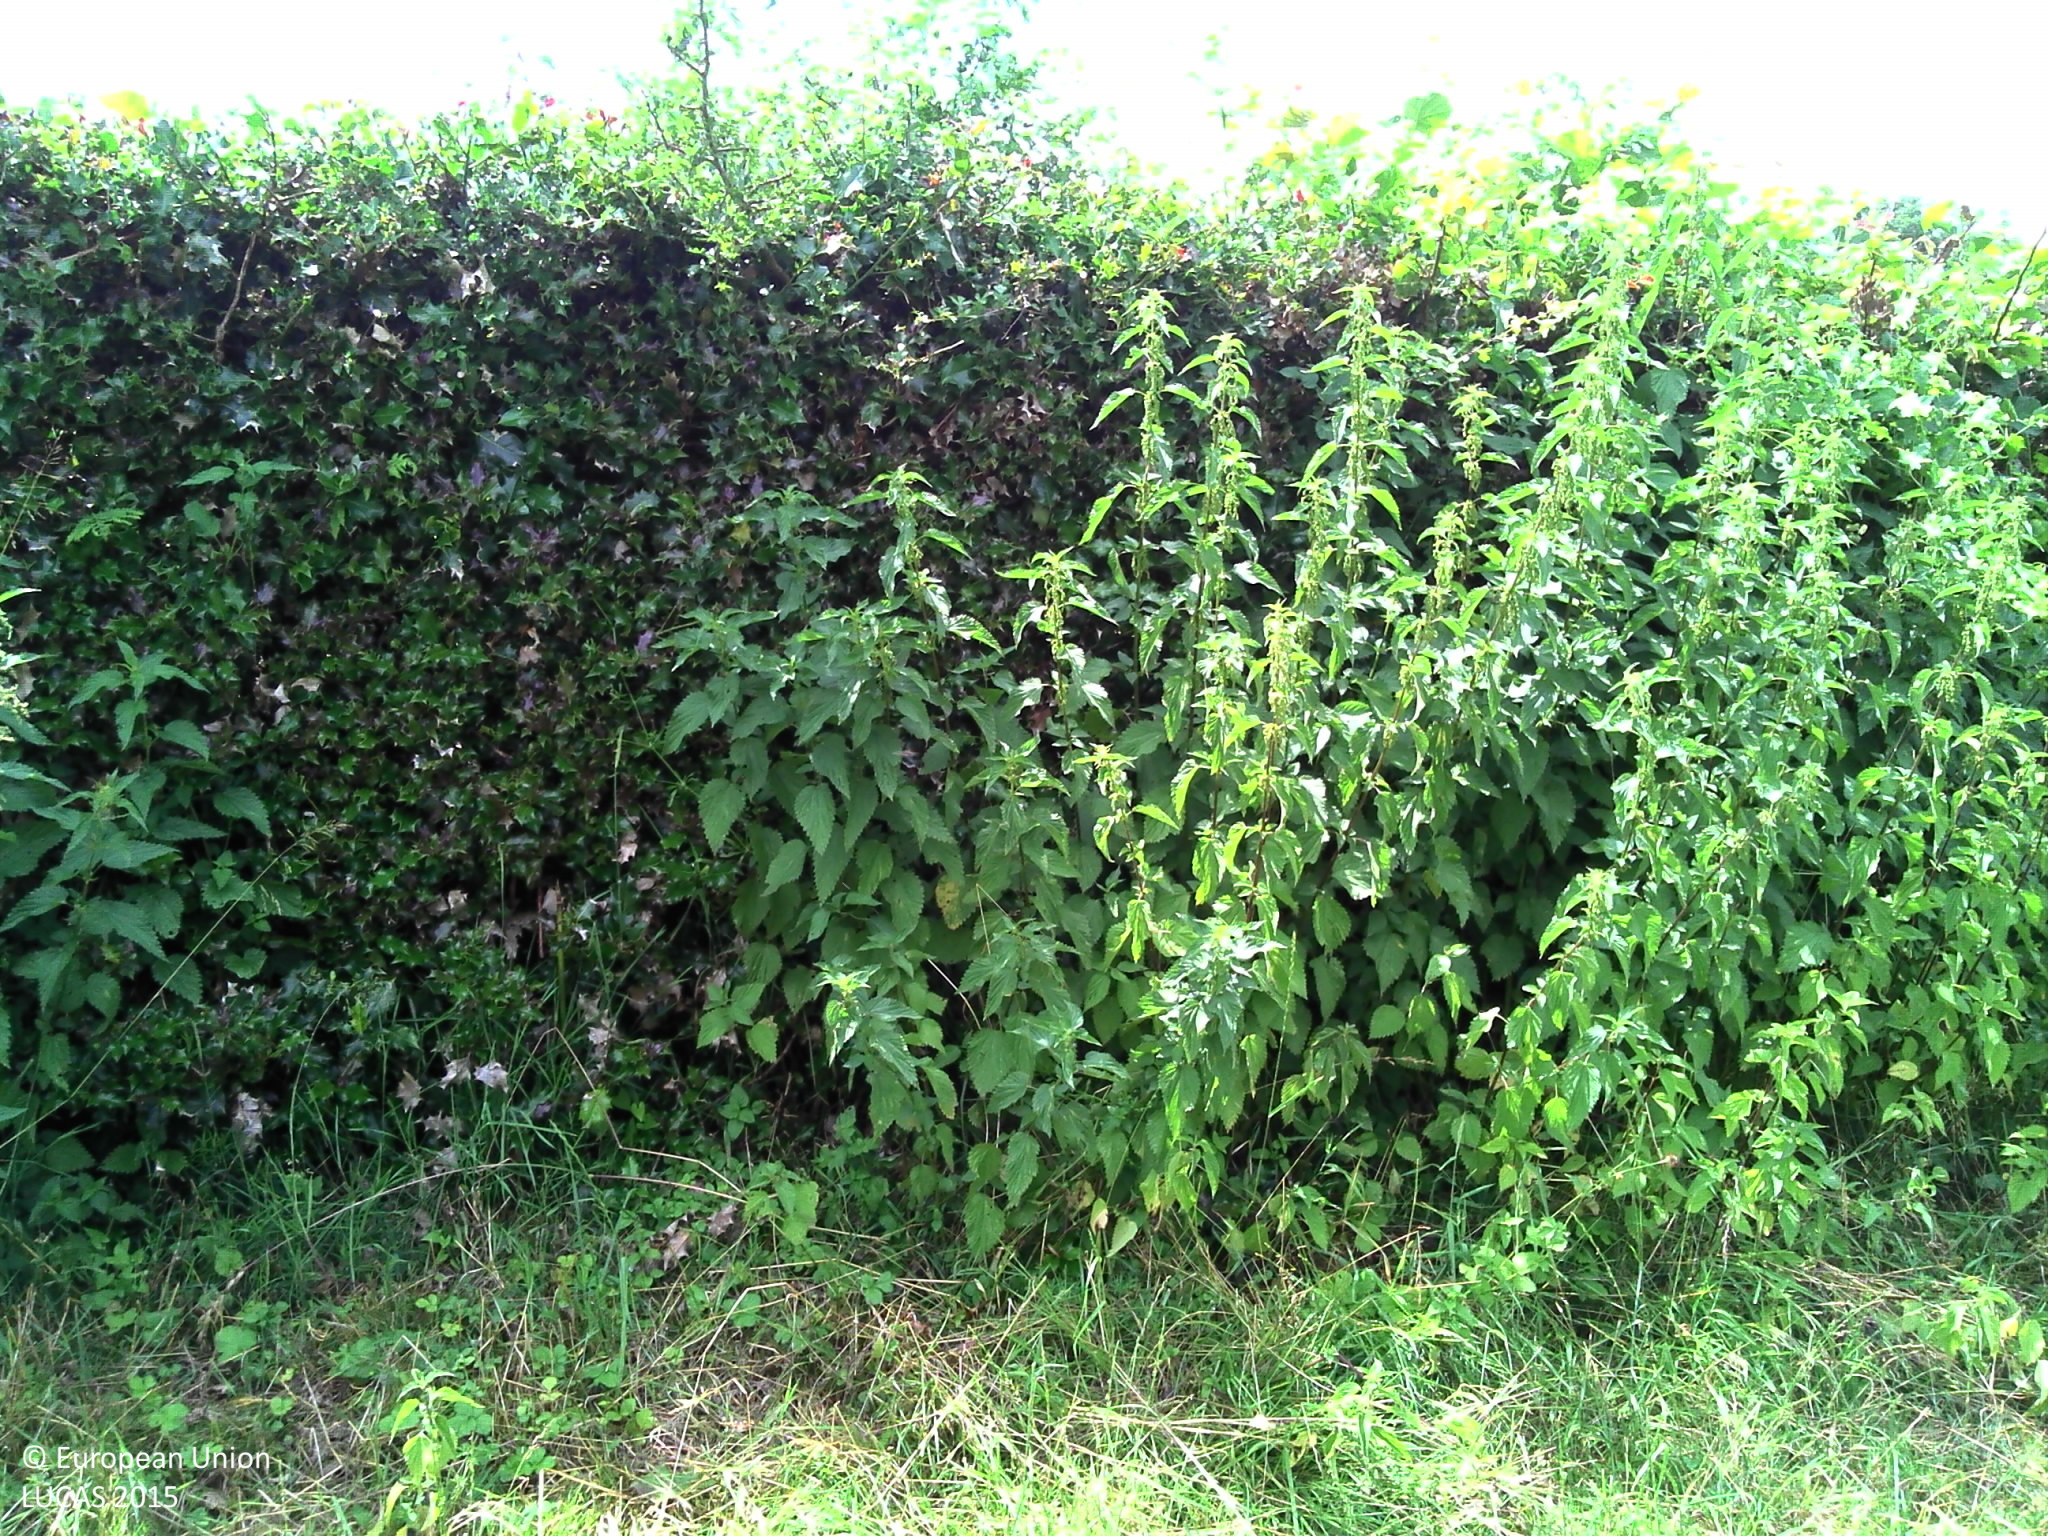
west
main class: Grassland
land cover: Grassland without tree/shrub cover
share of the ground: > 75 %
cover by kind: herbaceous plants 100 %
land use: Agriculture (excluding fallow land and kitchen gardens)
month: June
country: FR
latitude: 44.2780
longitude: 2.4983
